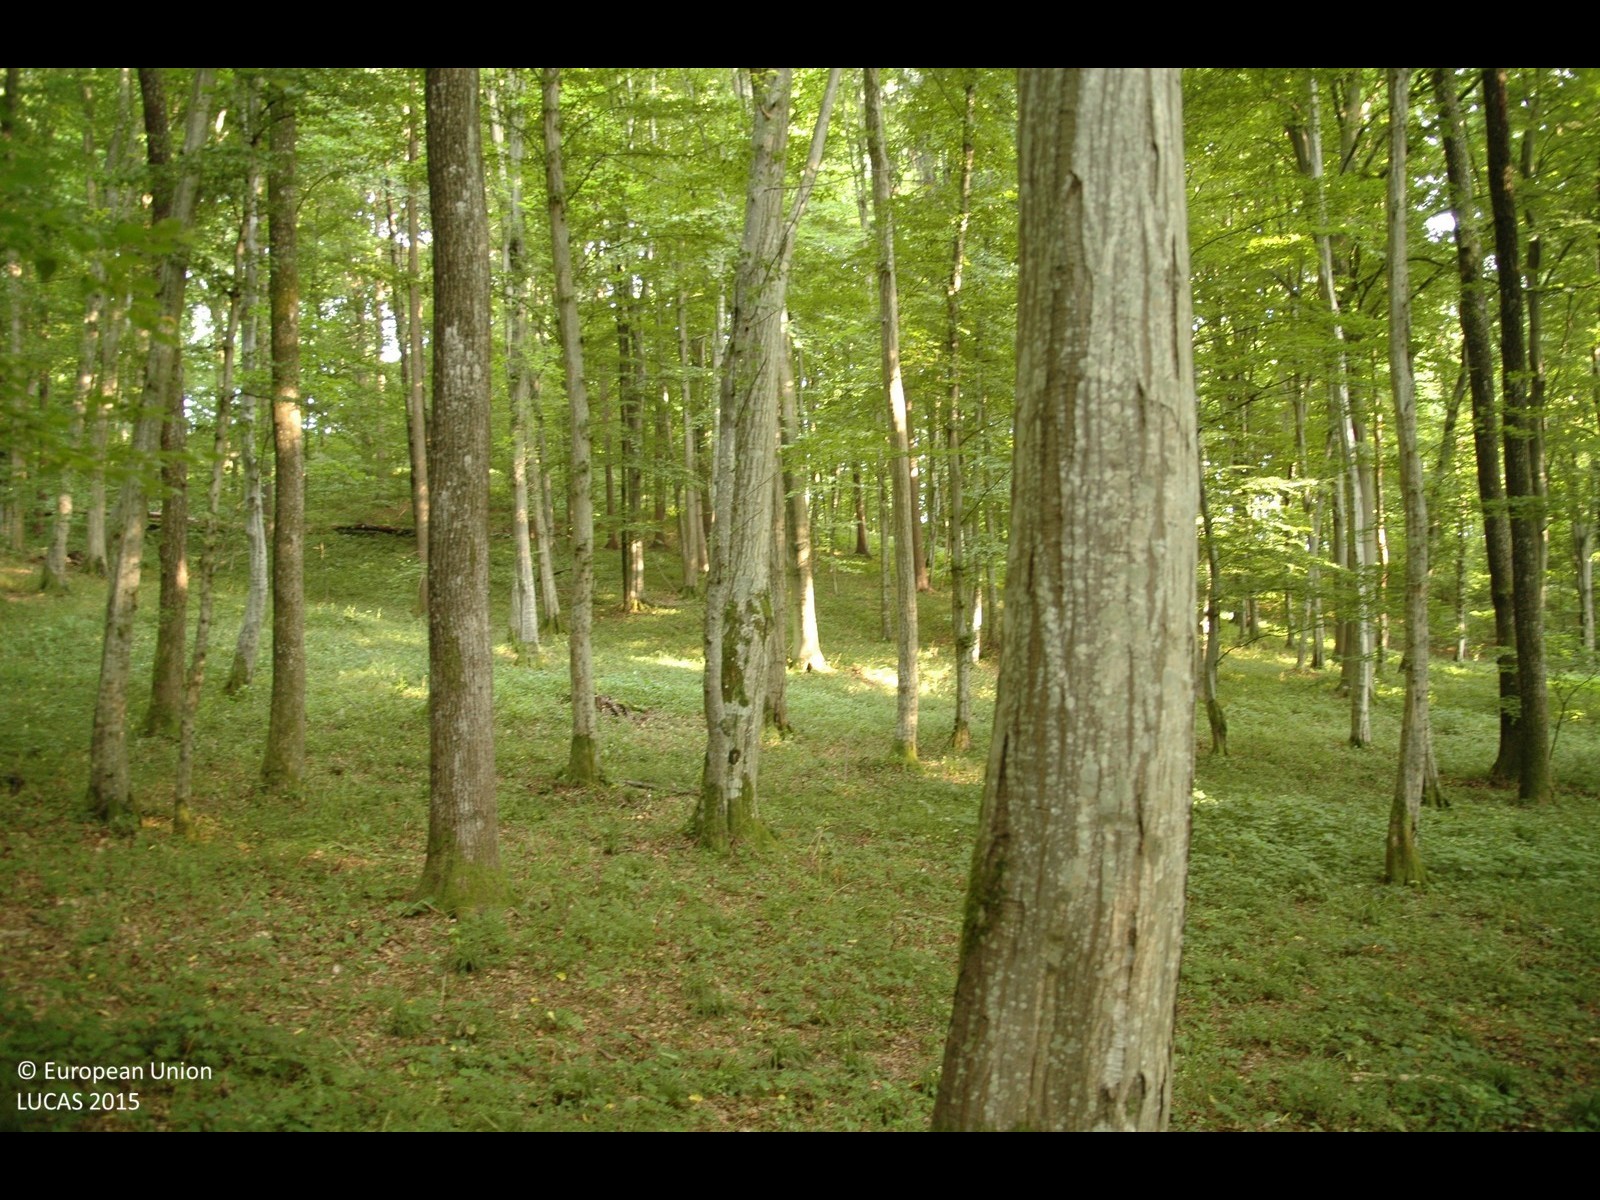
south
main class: Woodland
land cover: Broadleaved woodland
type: mesophytic deciduous forest
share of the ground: > 75 %
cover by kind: broadleaved forest trees 100 %
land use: Forestry
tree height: > 5 m
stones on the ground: < 10 %
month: June
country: HR
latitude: 46.4536
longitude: 16.3148
